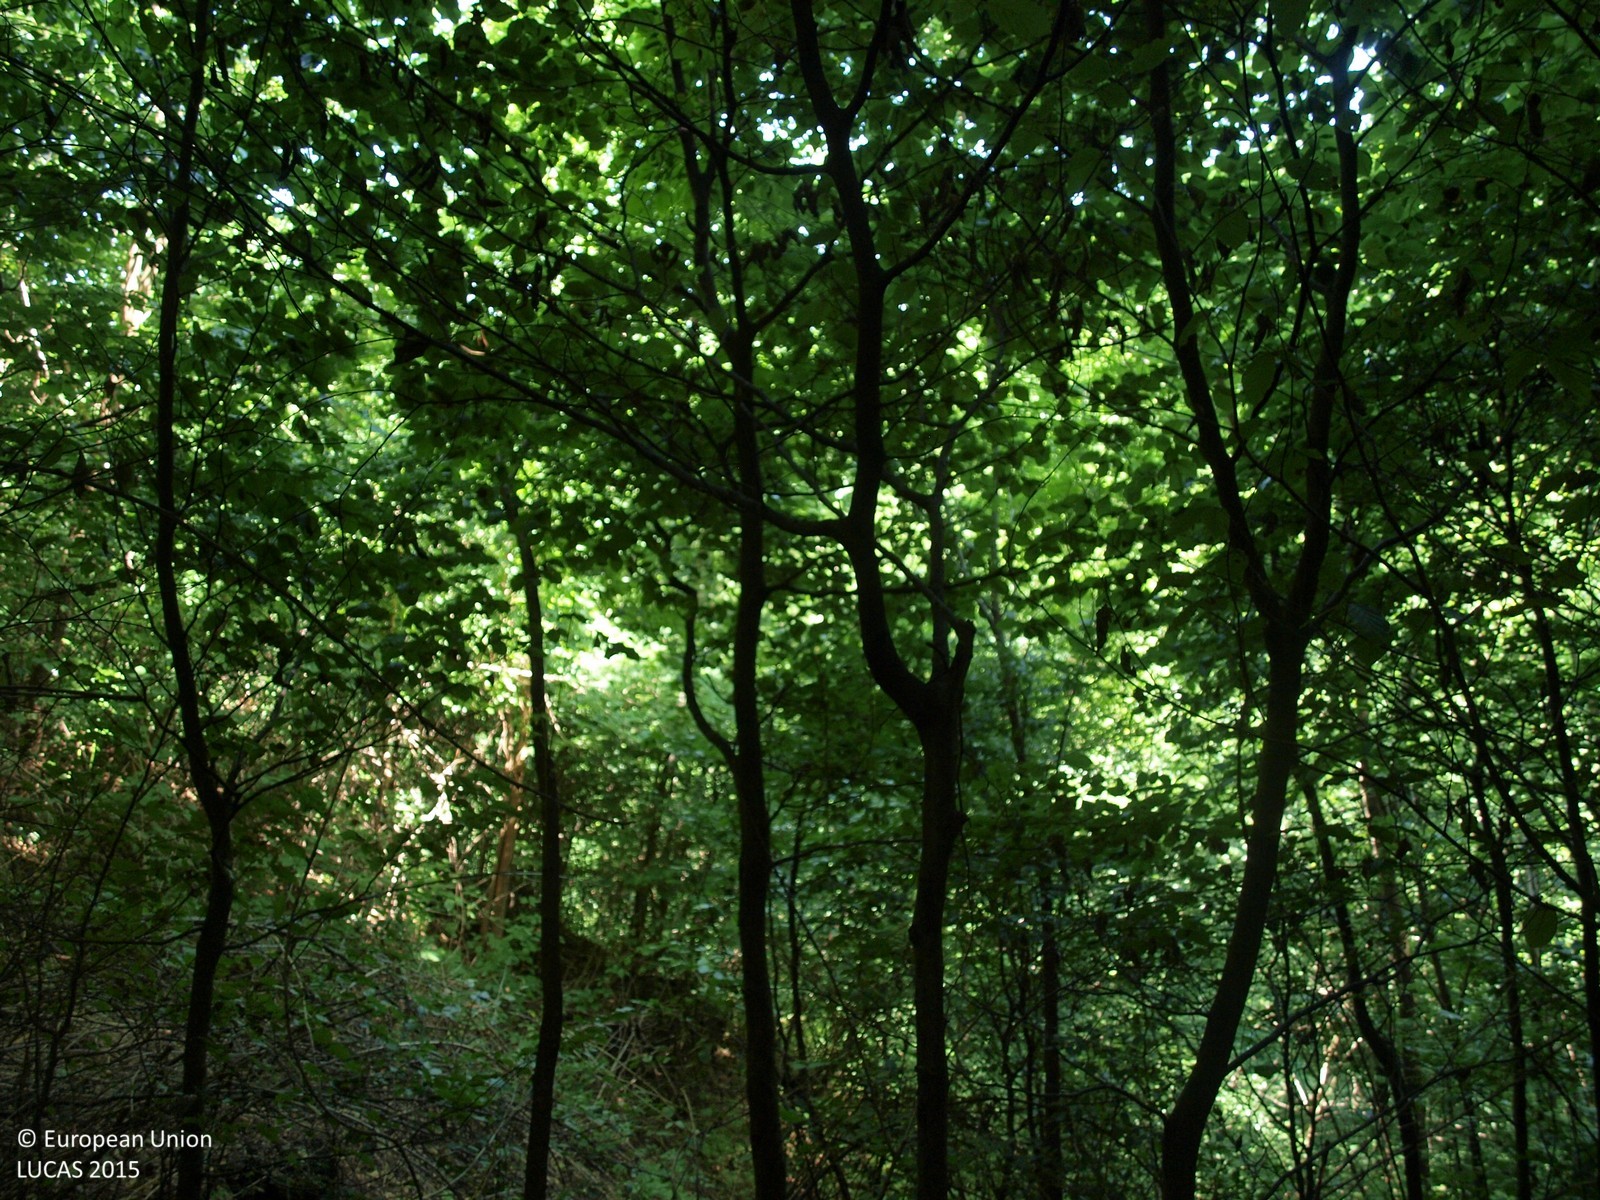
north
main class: Woodland
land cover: Broadleaved woodland
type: beech forest
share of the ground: > 75 %
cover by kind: broadleaved forest trees 100 %
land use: Forestry
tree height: > 5 m
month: August
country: HR
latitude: 46.0005
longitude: 16.3393
